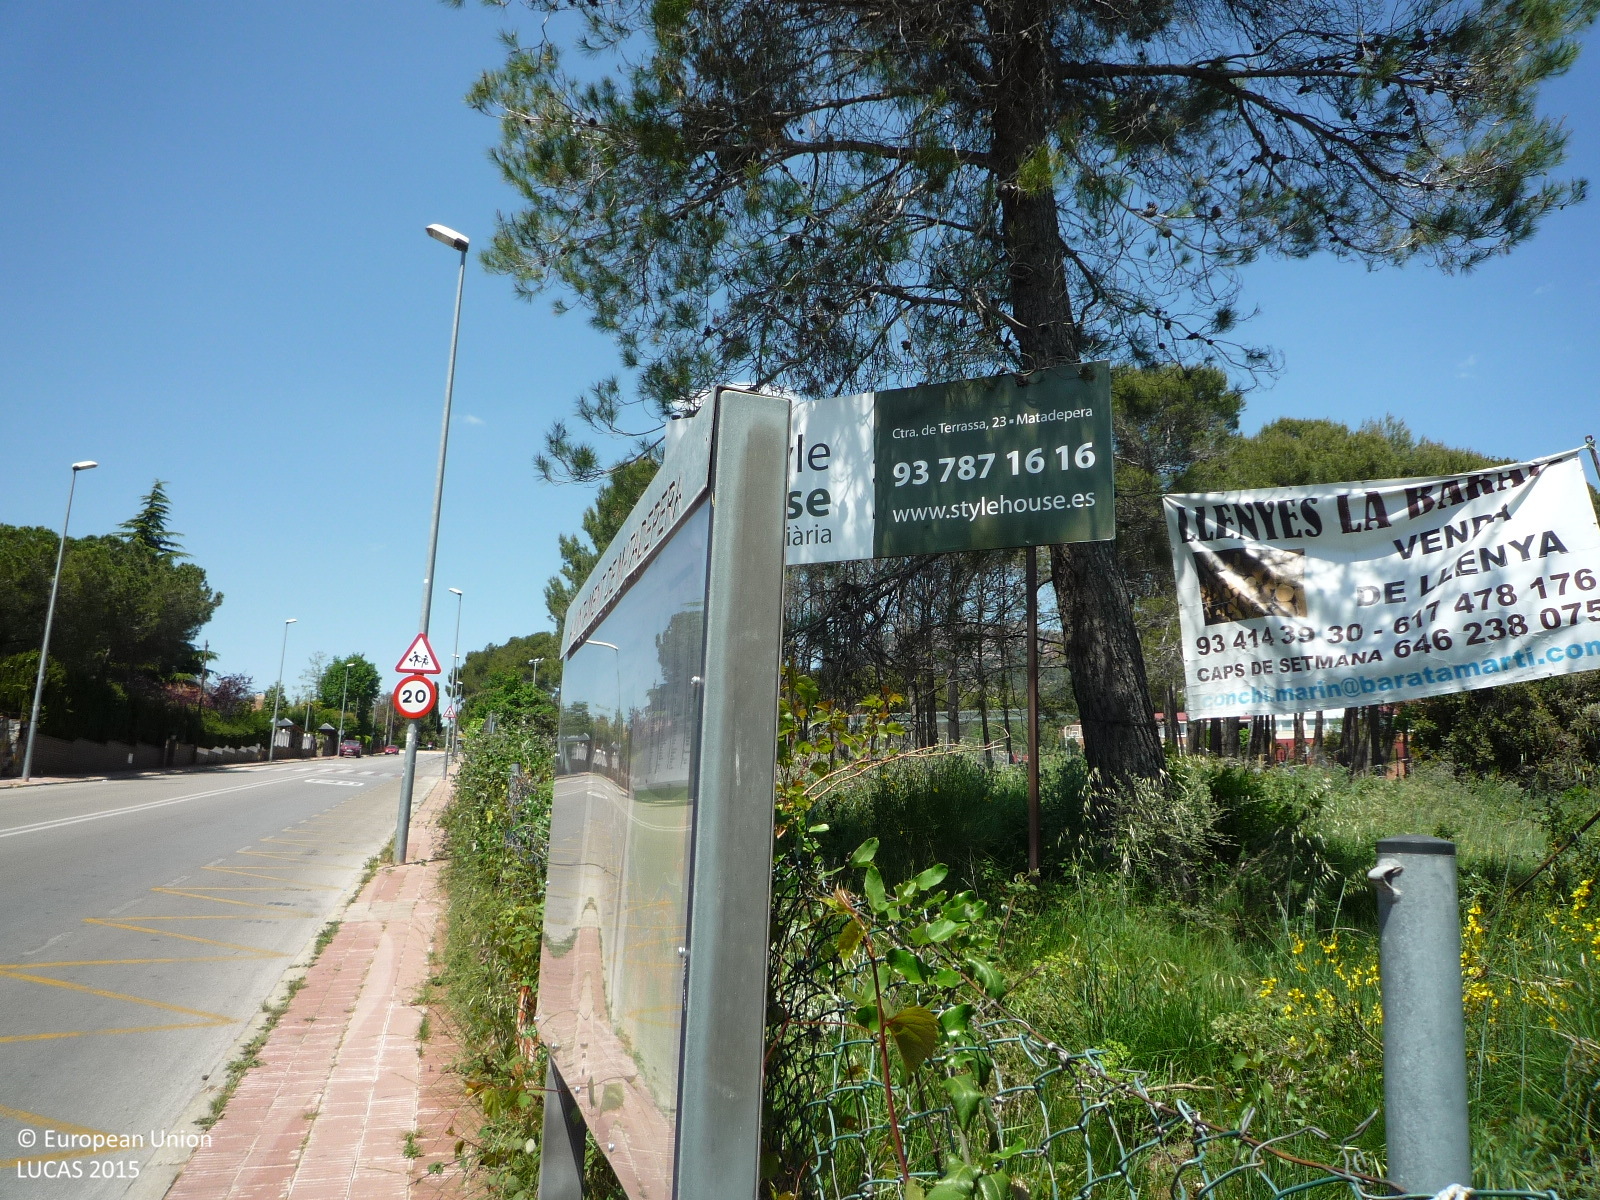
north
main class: Grassland
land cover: Grassland with sparse tree/shrub cover
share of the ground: > 75 %
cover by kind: herbaceous plants 95 %, broadleaved forest trees 5 %
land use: Abandoned areas
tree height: < 5 m
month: May
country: ES
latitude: 41.6123
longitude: 2.0122
